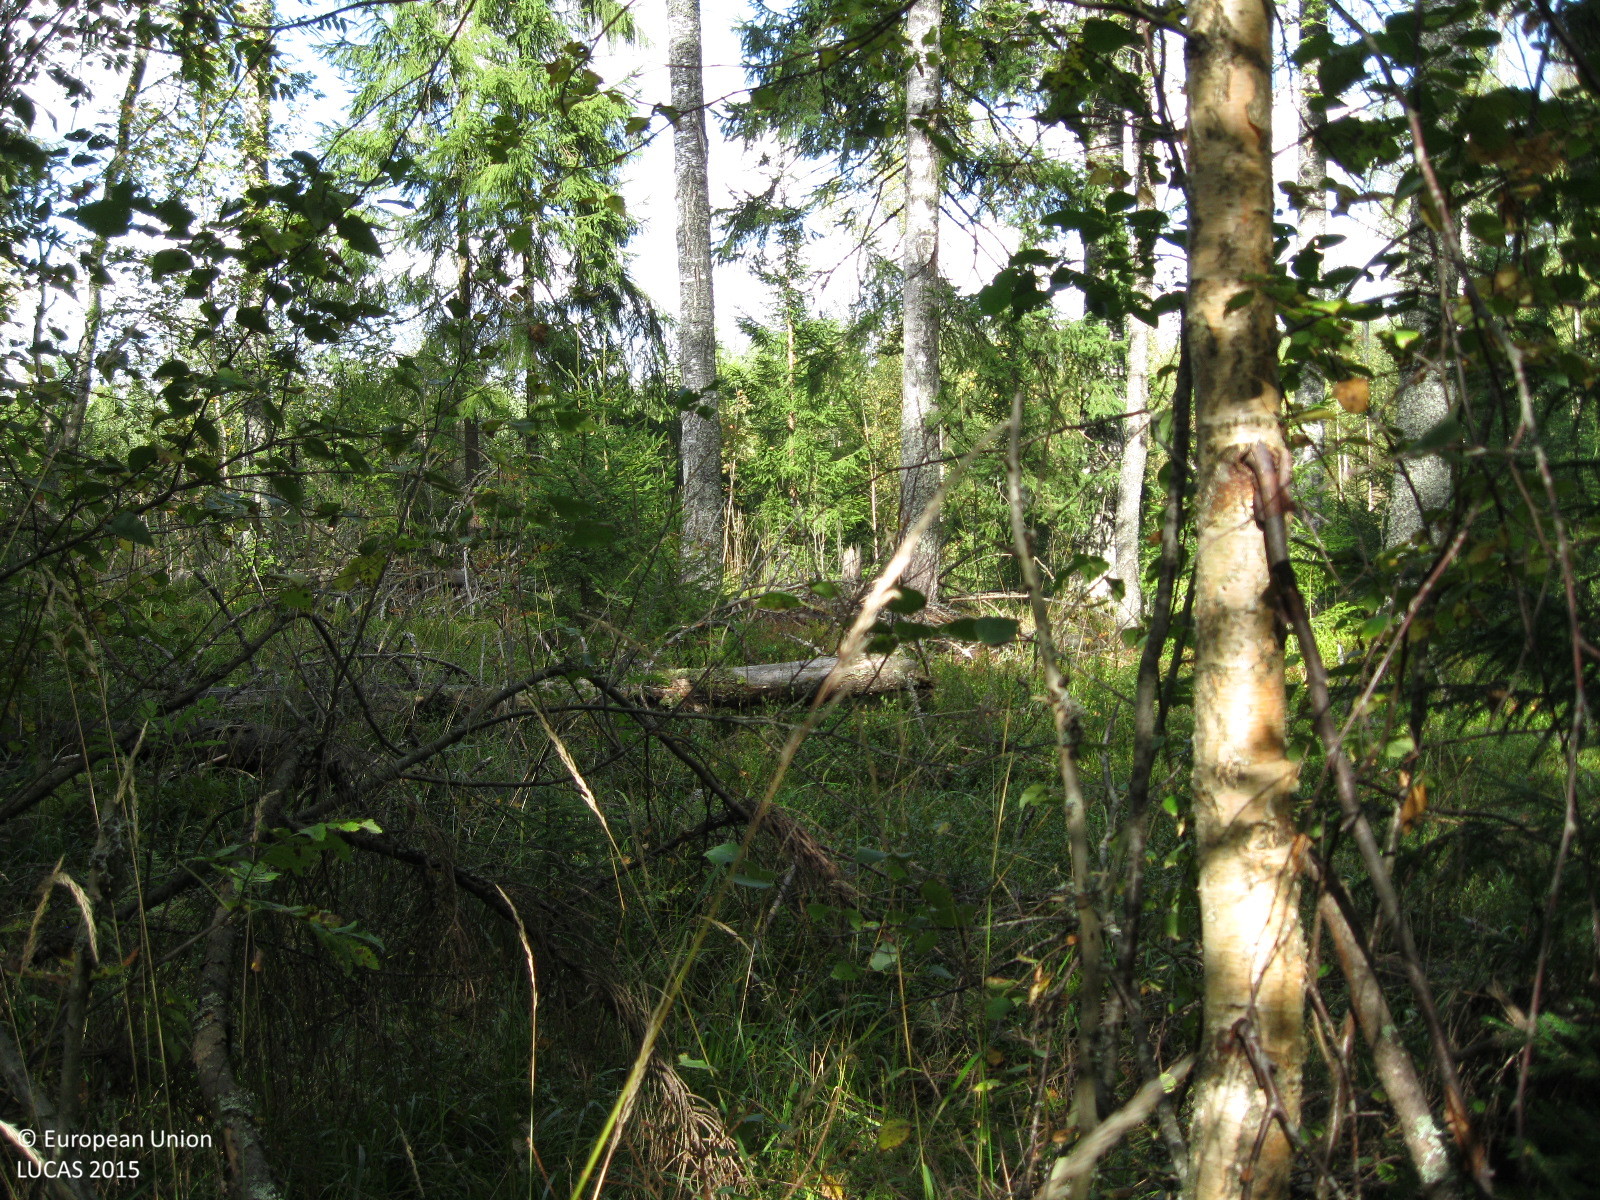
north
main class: Woodland
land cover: Broadleaved woodland
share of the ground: > 75 %
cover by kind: broadleaved forest trees 90 %, shrubs 5 %, herbaceous plants 5 %
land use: Forestry
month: September
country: FI
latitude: 60.3773
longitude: 24.5267
